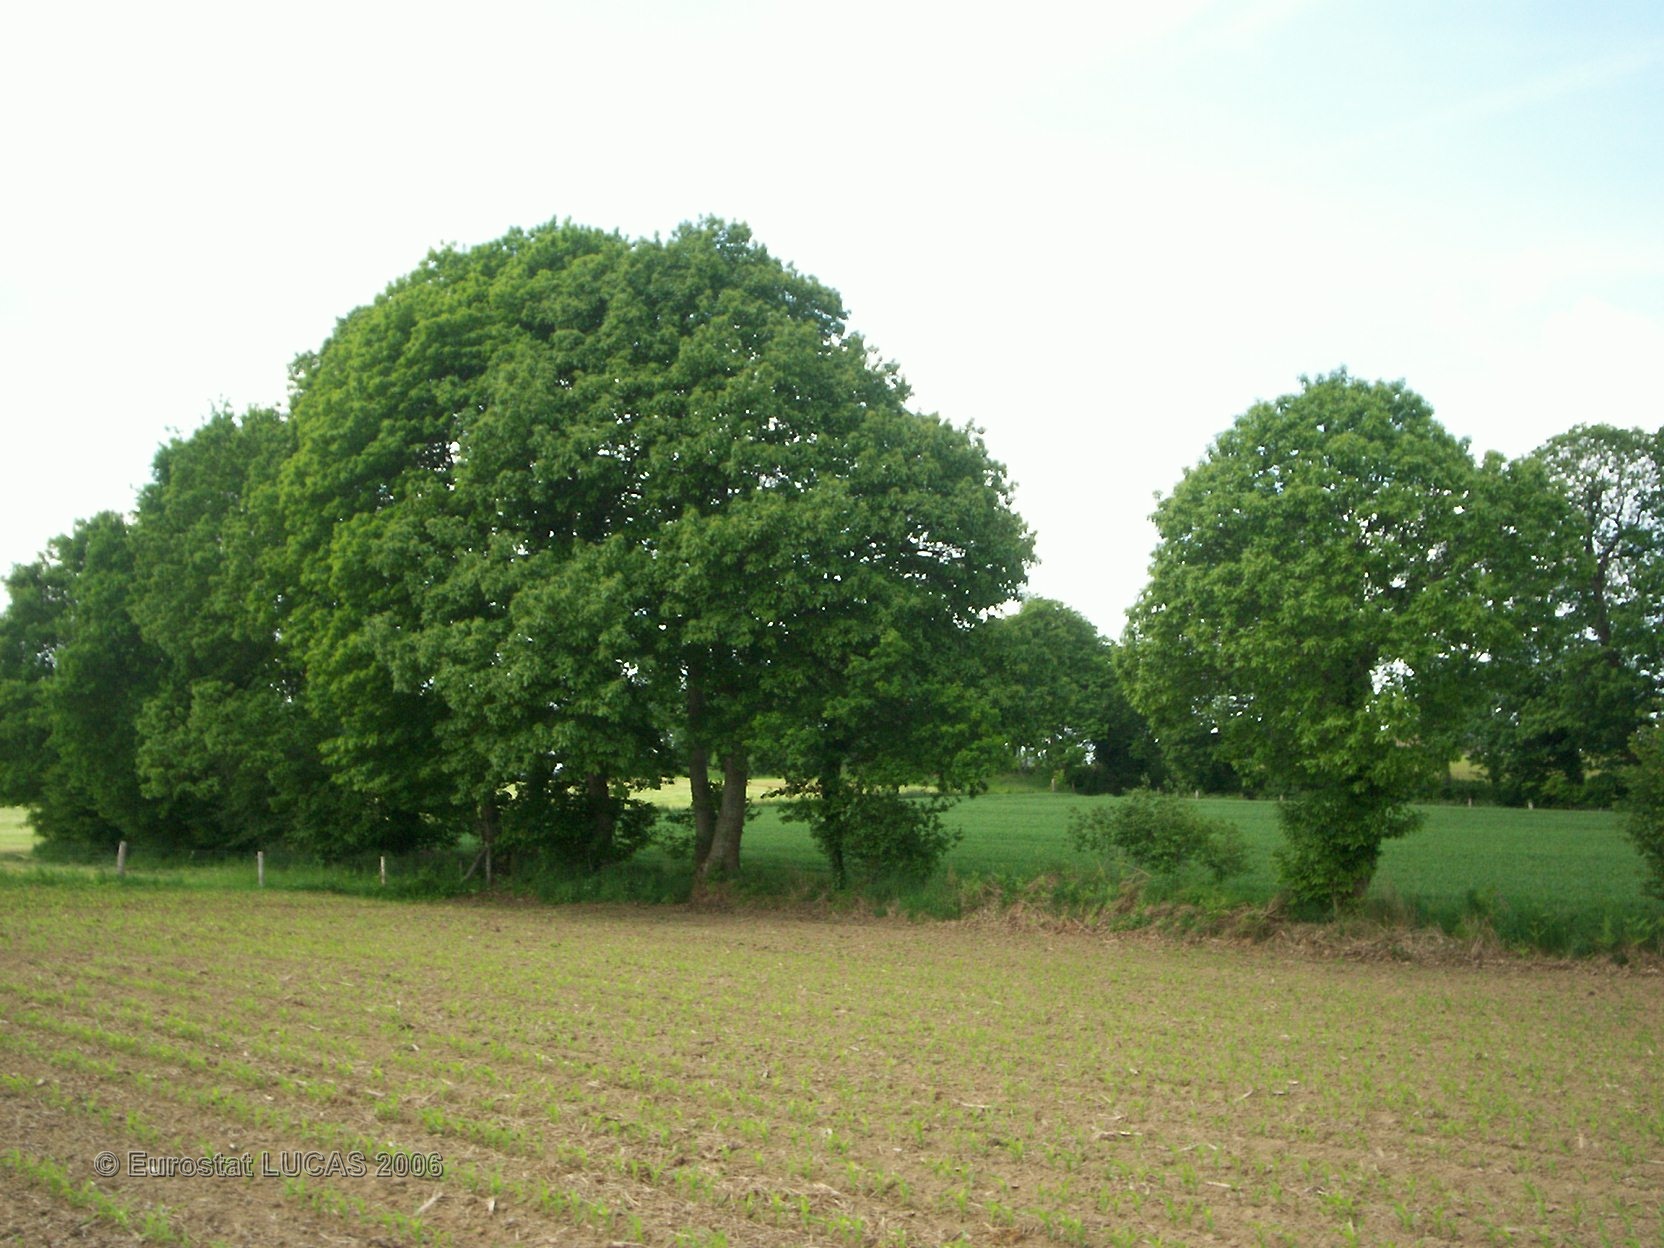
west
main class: Cropland
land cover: Maize
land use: Agriculture (excluding fallow land and kitchen gardens)
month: June
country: FR
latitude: 48.4476
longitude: -1.2241
